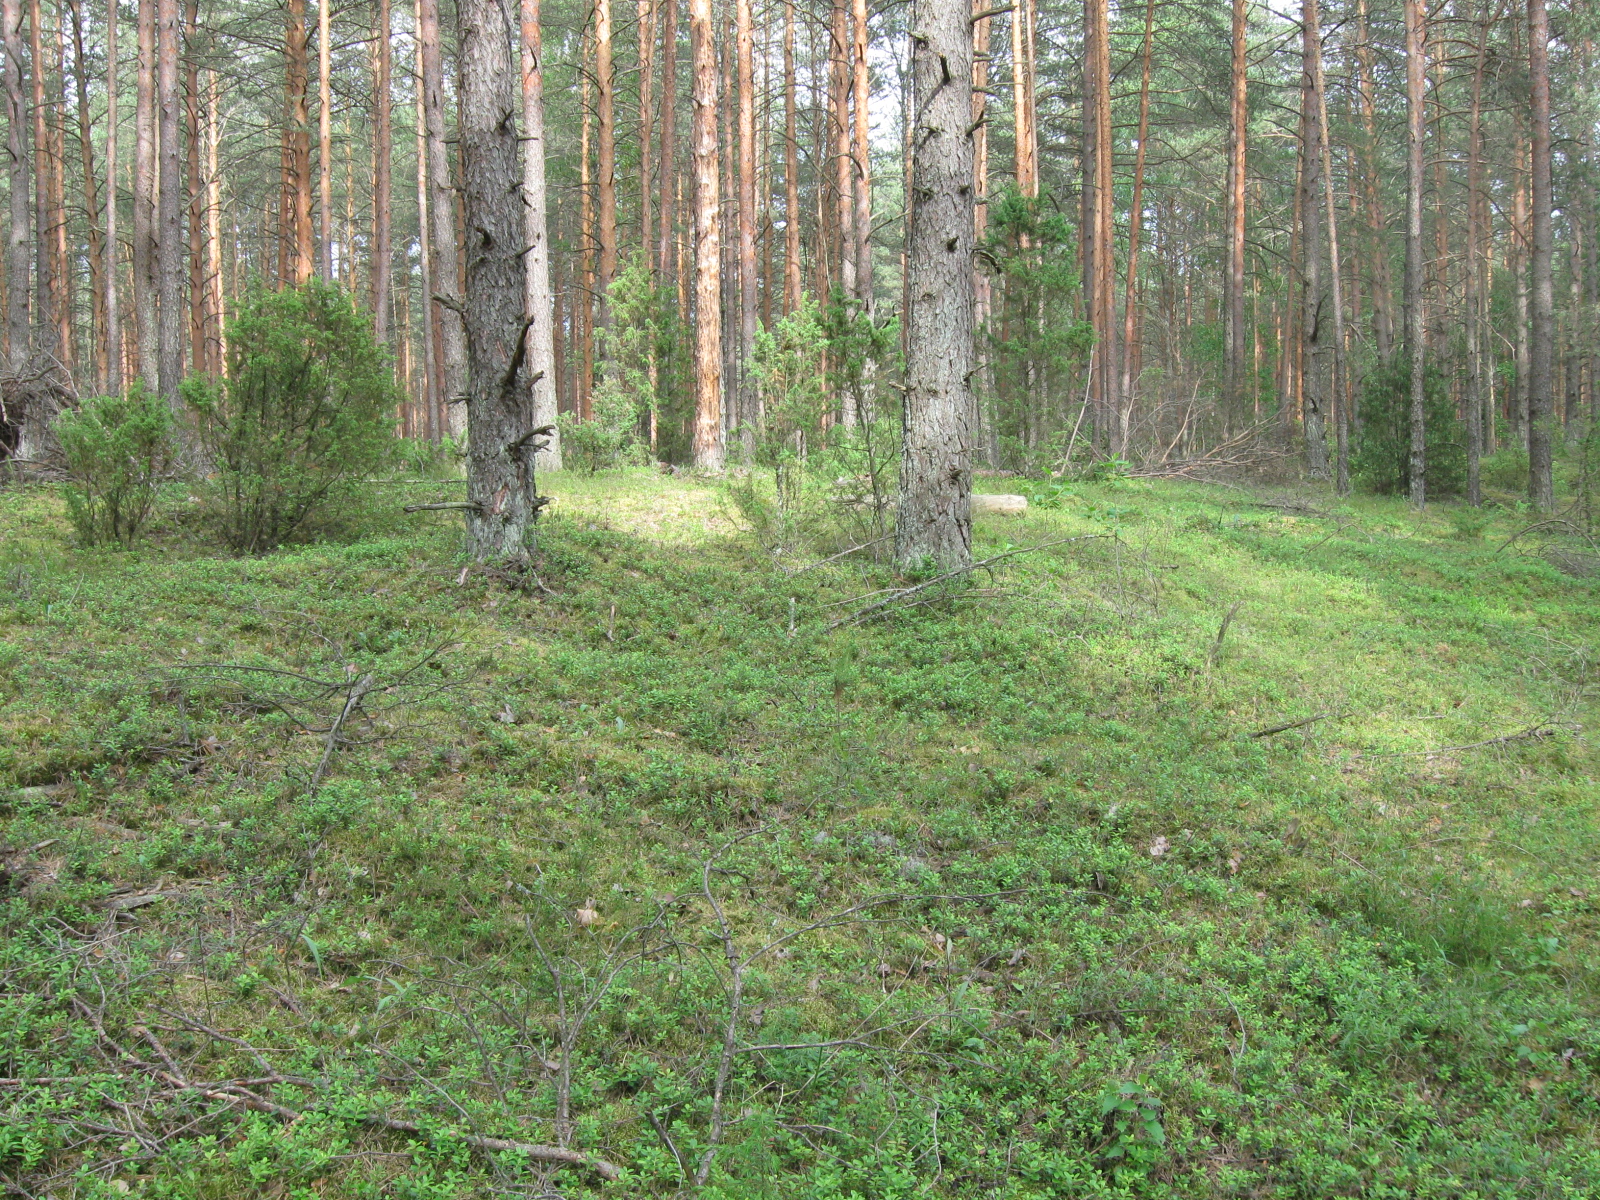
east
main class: Woodland
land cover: Pine dominated coniferous woodland
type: hemiboreal forest and nemoral coniferous forest and mixed broadleaved-coniferous forest
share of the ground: > 75 %
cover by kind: coniferous forest trees 80 %, lichens and mosses 15 %, herbaceous plants 5 %
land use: Forestry
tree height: > 5 m
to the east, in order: Pine dominated coniferous woodland; Paved roads, cycling and walking lanes; Pine dominated coniferous woodland
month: June
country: LT
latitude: 54.2084
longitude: 24.6263
